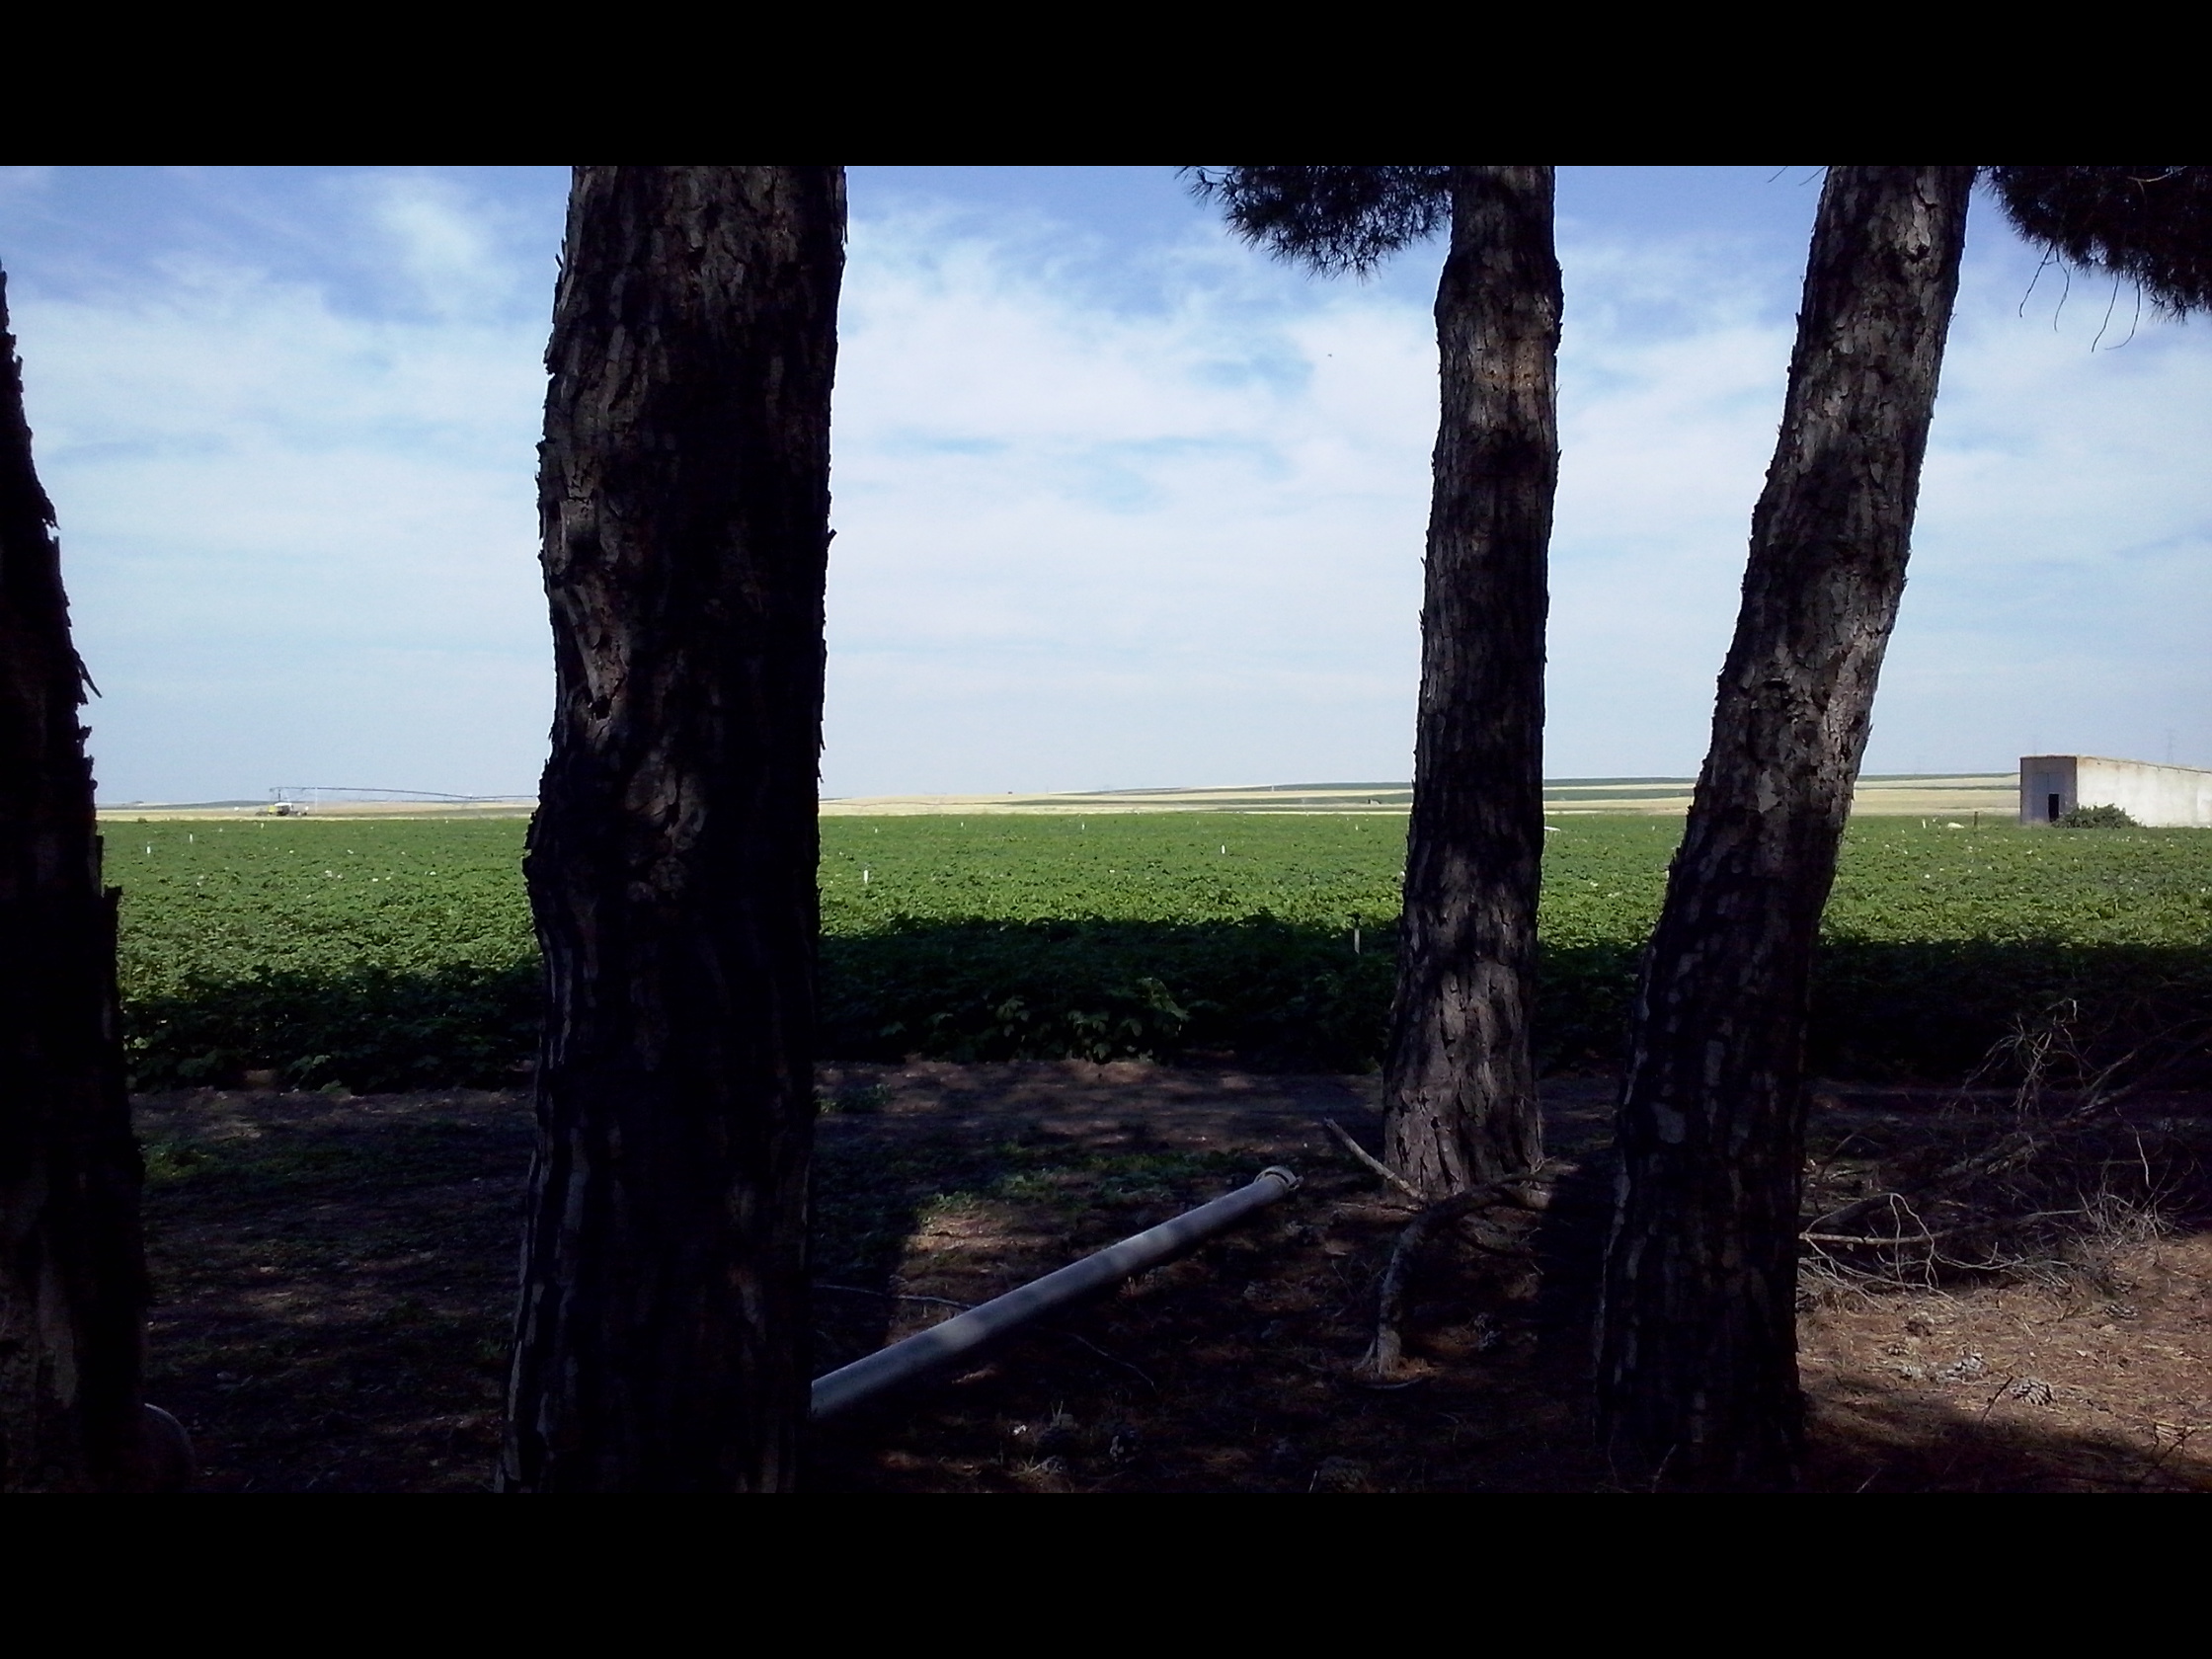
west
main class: Woodland
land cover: Pine dominated coniferous woodland
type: coniferous forest of the mediterranean region
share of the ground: 50 - 75 %
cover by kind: coniferous forest trees 60 %, herbaceous plants 25 %, unconsolidated bare surface 15 %
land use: Forestry
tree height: > 5 m
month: July
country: ES
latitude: 41.5163
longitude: -5.0879
